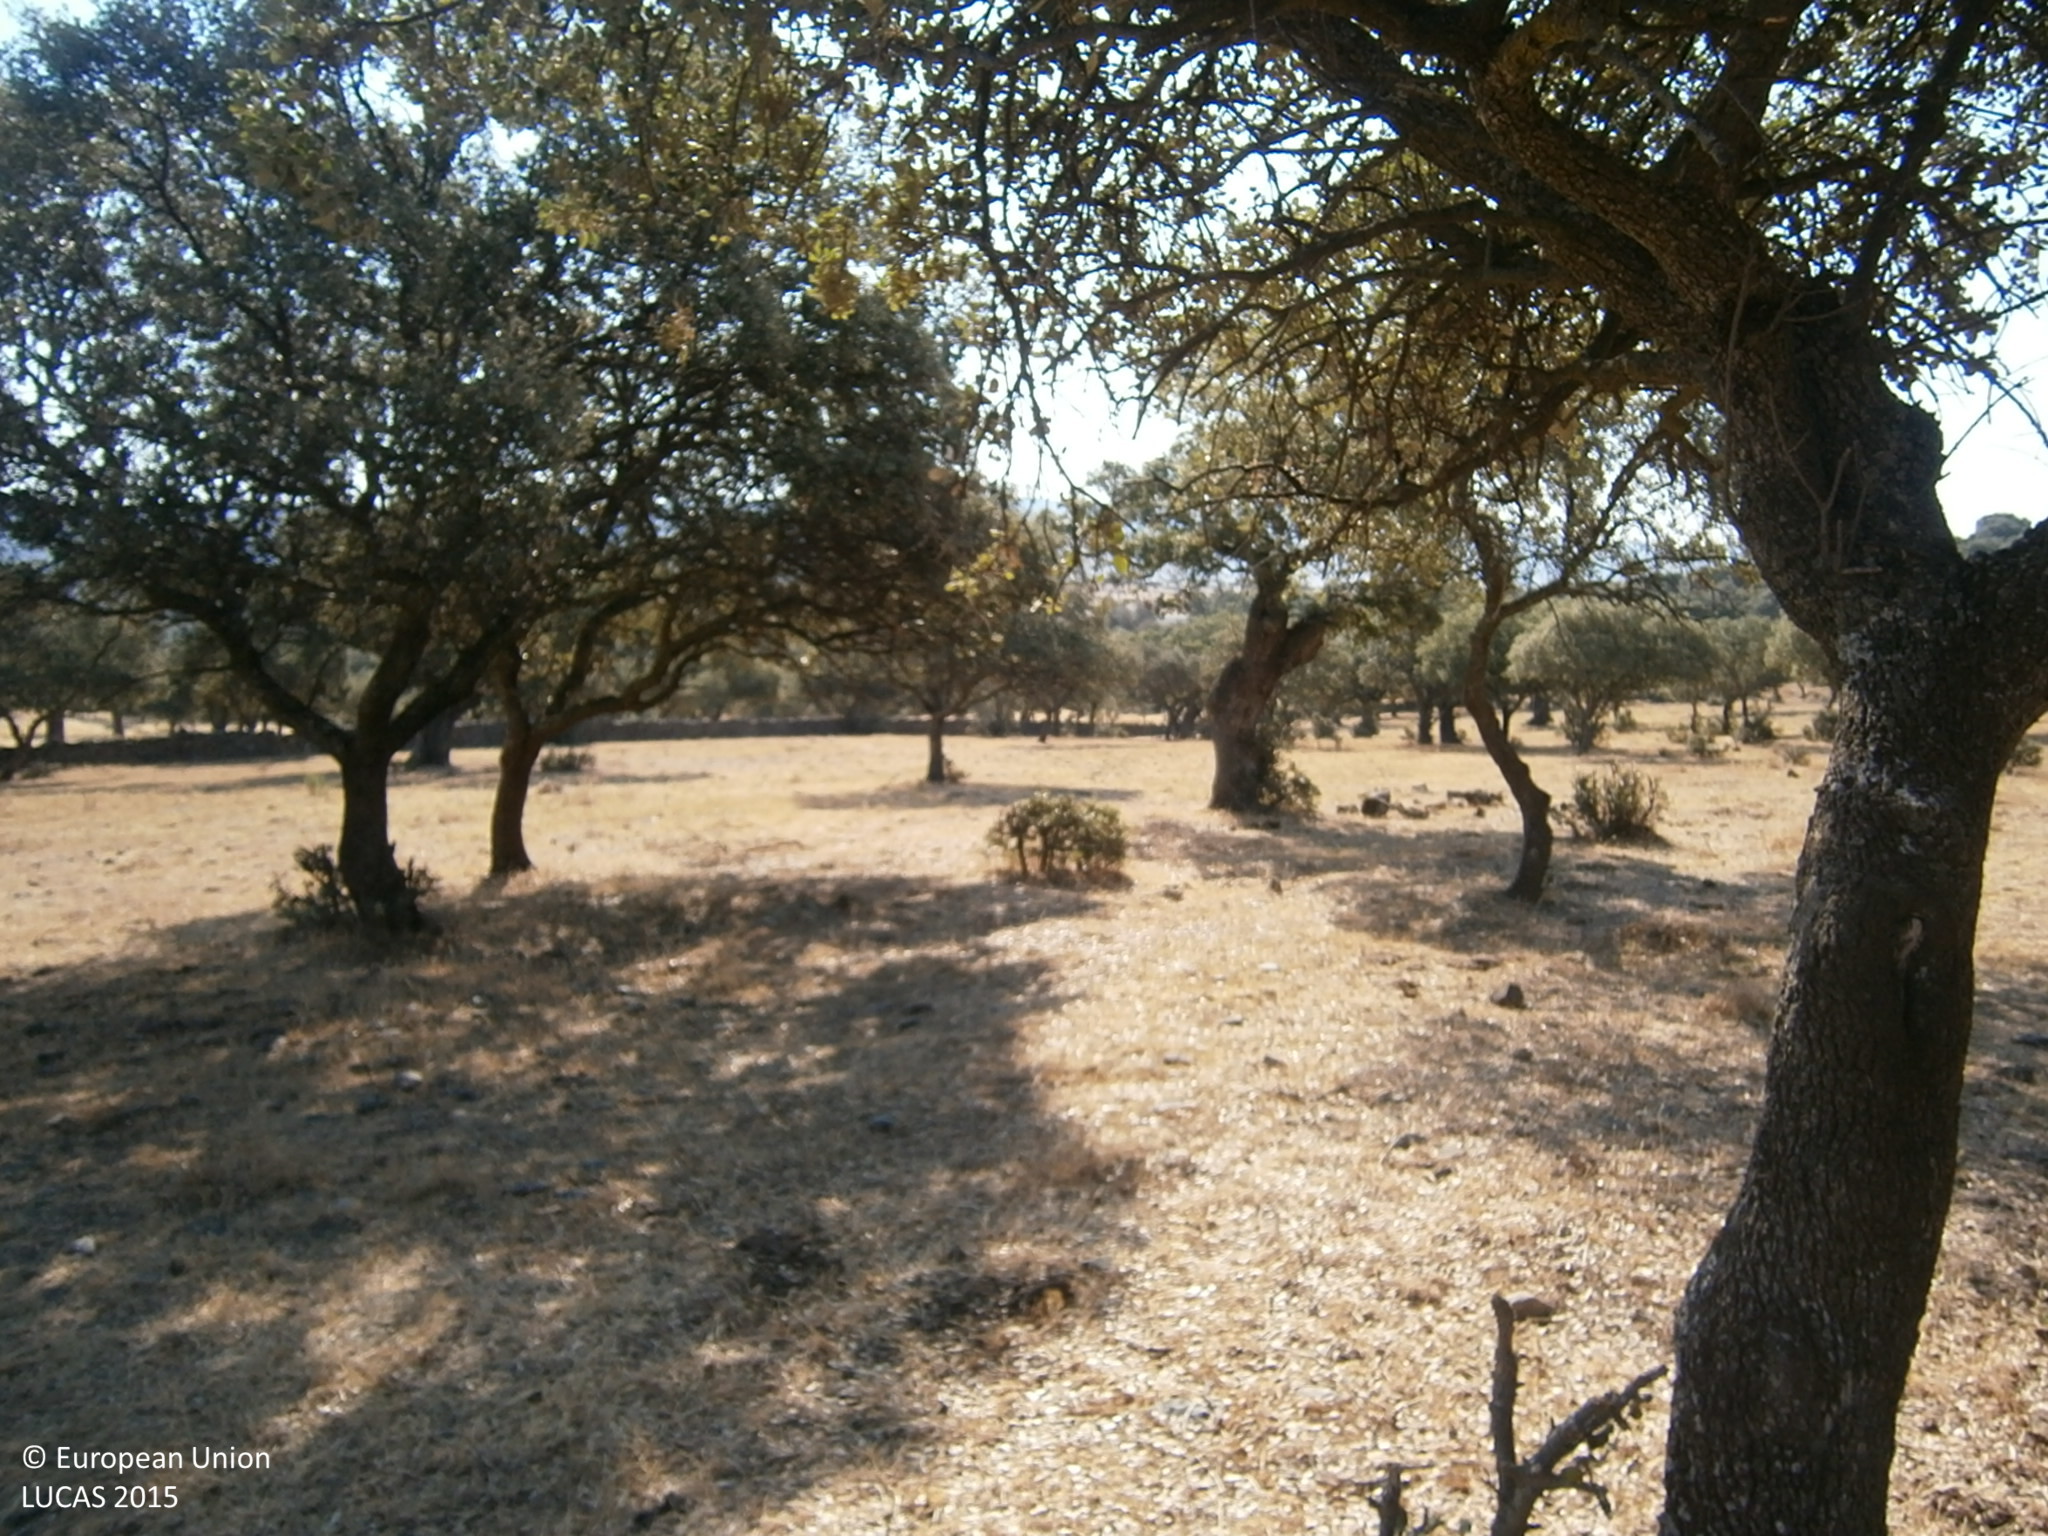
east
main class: Woodland
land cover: Broadleaved woodland
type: broadleaved evergreen forest
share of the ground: > 75 %
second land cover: Spontaneously vegetated surfaces
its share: > 75 %
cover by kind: broadleaved forest trees 90 %, unconsolidated bare surface 5 %
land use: Forestry
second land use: Agriculture (excluding fallow land and kitchen gardens)
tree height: > 5 m
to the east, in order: Broadleaved woodland; Spontaneously vegetated surfaces; Dry stone walls; Broadleaved woodland; Artificial constructions in urban areas
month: June
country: ES
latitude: 38.5565
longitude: -6.7561
